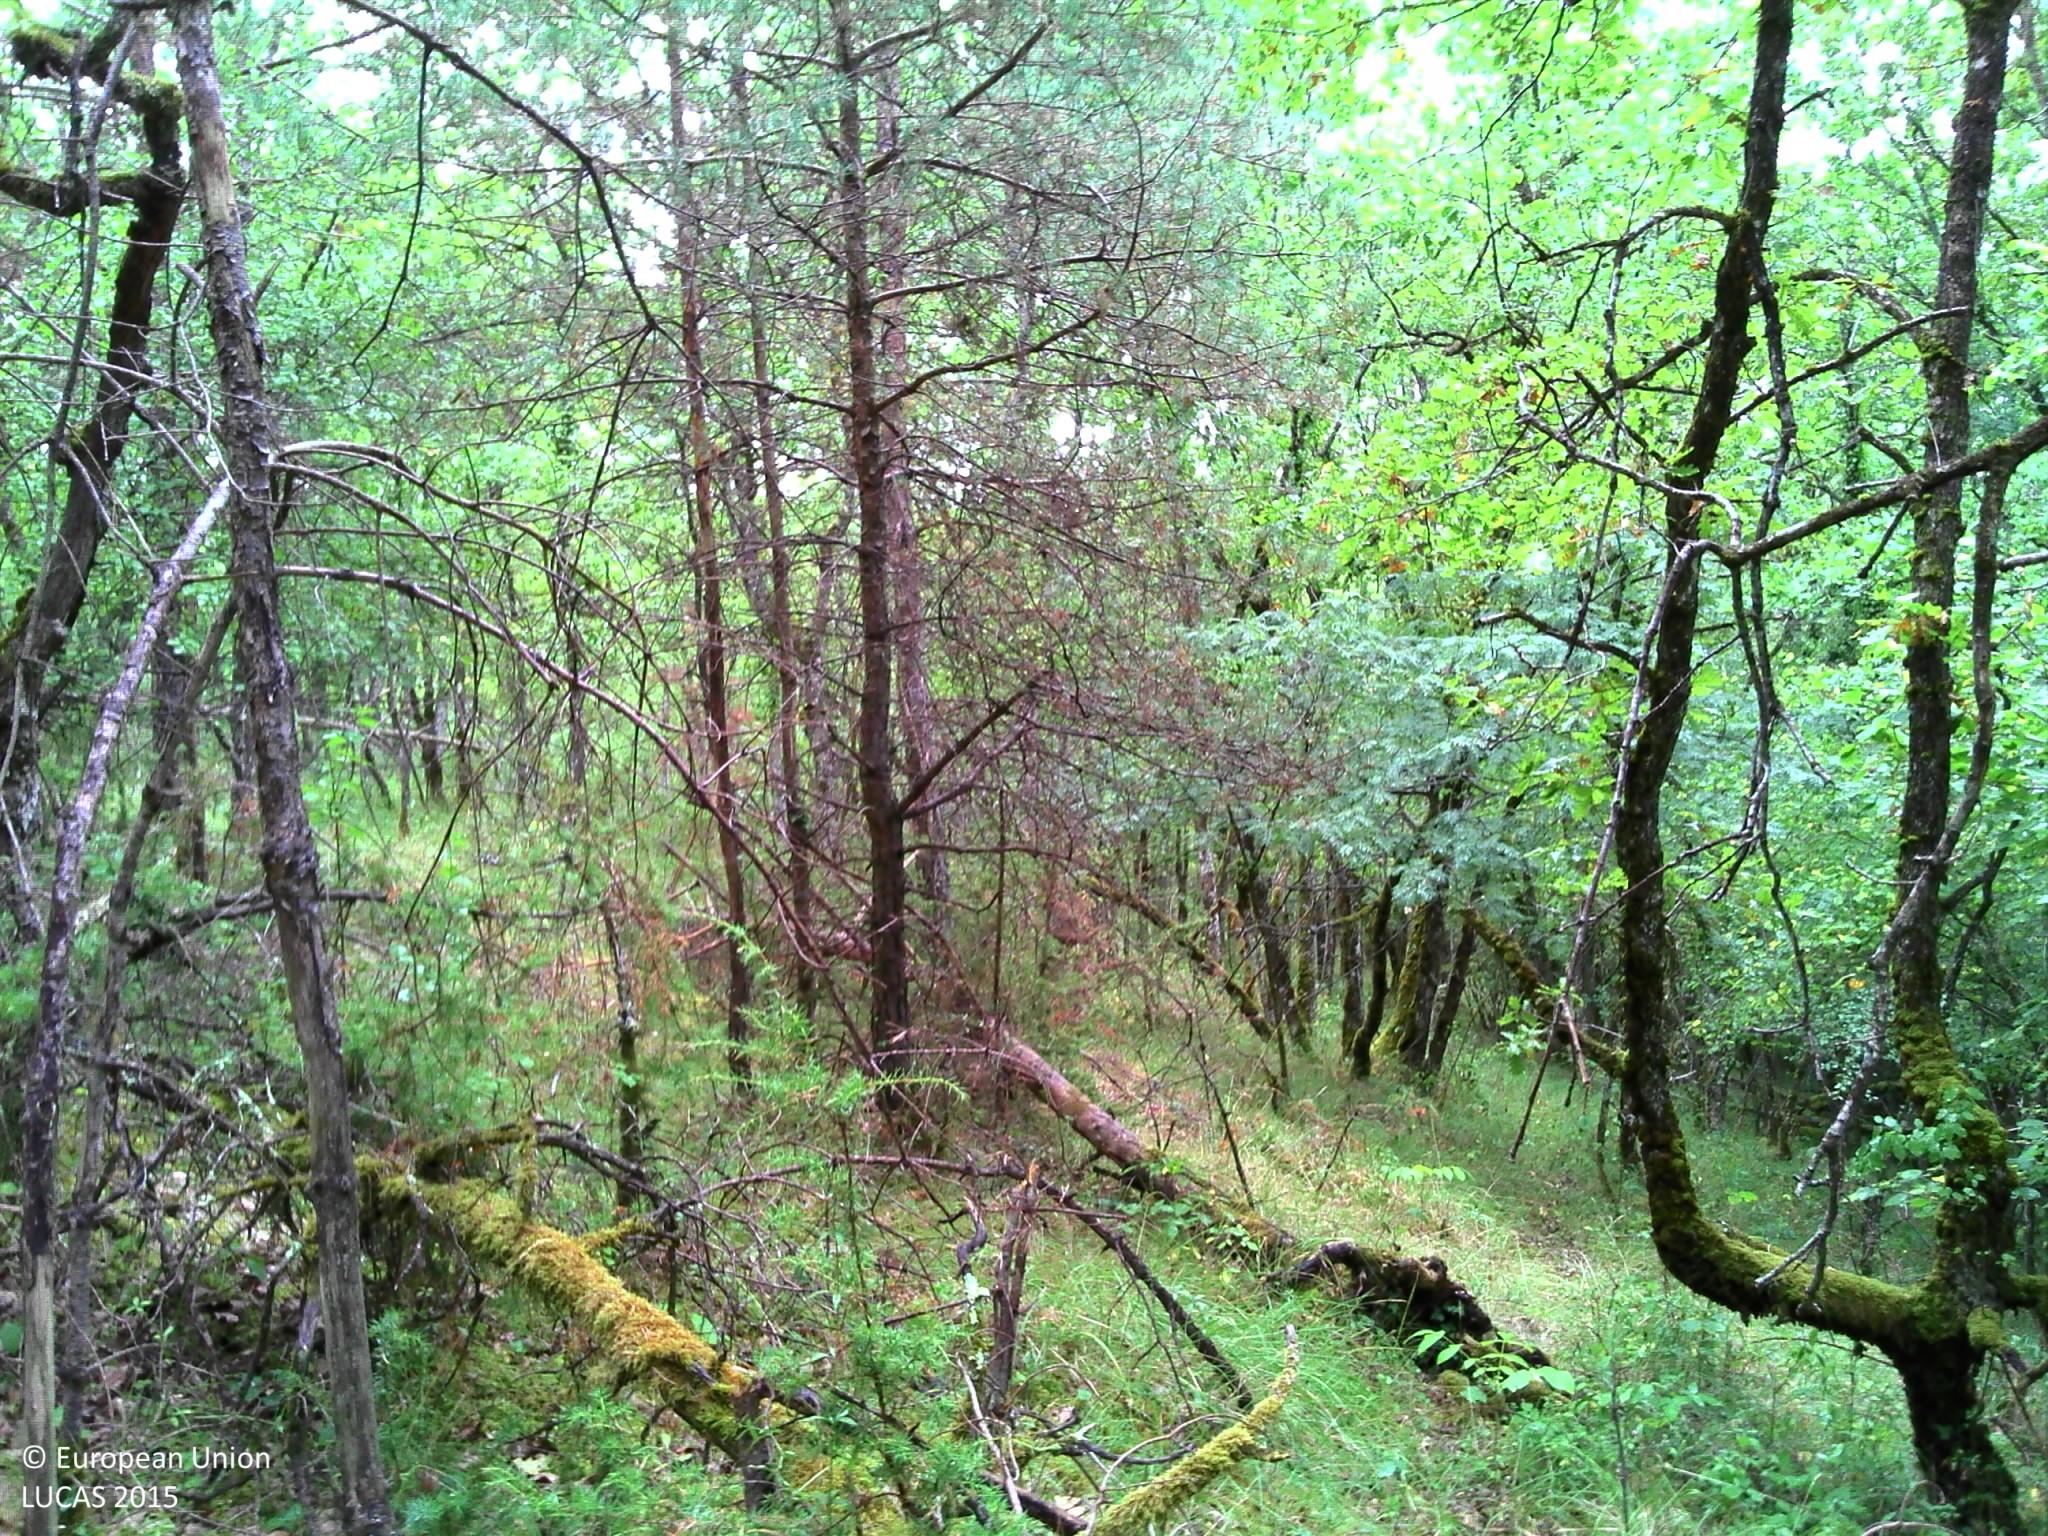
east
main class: Woodland
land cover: Pine dominated mixed woodland
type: hemiboreal forest and nemoral coniferous forest and mixed broadleaved-coniferous forest
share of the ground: > 75 %
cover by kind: broadleaved forest trees 50 %, coniferous forest trees 30 %, shrubs 10 %, herbaceous plants 10 %
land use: Forestry
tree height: > 5 m
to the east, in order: Pine dominated mixed woodland; Fences; Tracks; Broadleaved woodland
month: July
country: FR
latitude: 44.9012
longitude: 0.7852
